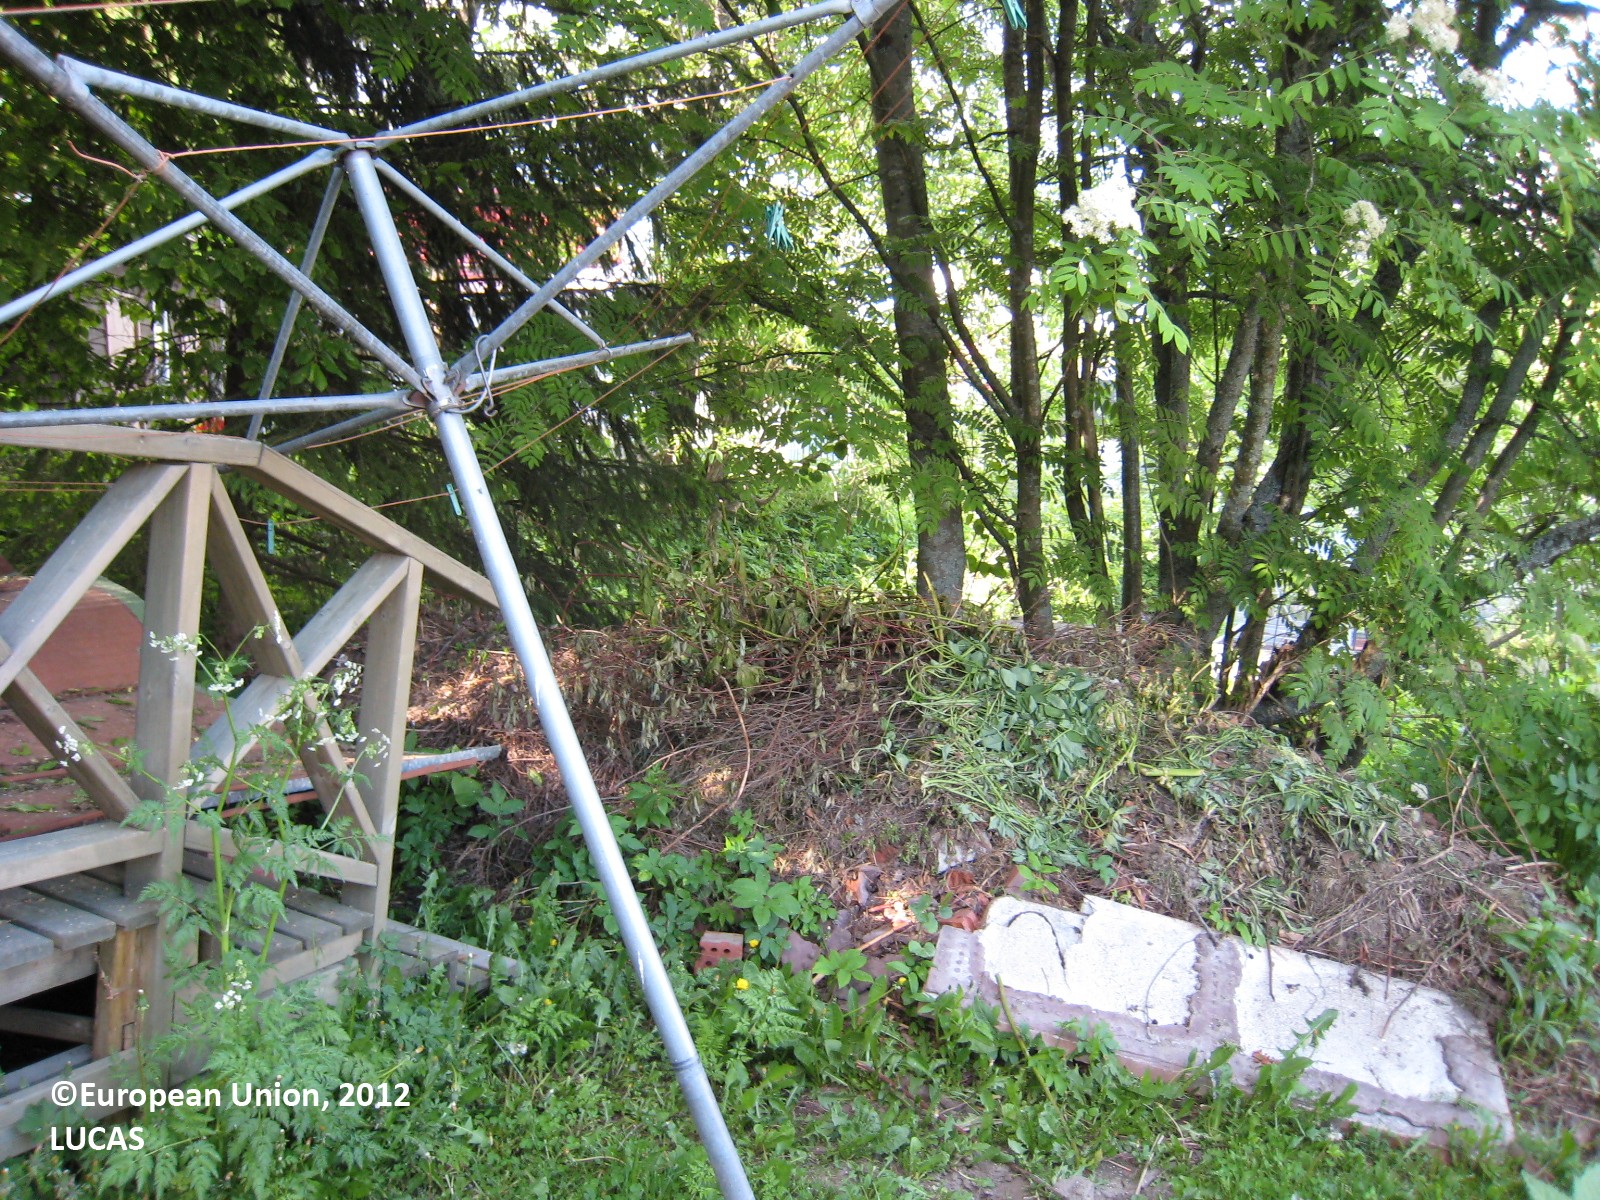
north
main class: Grassland
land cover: Grassland with sparse tree/shrub cover
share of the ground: > 75 %
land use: Residential
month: June
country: FI
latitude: 62.2448
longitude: 25.8487
